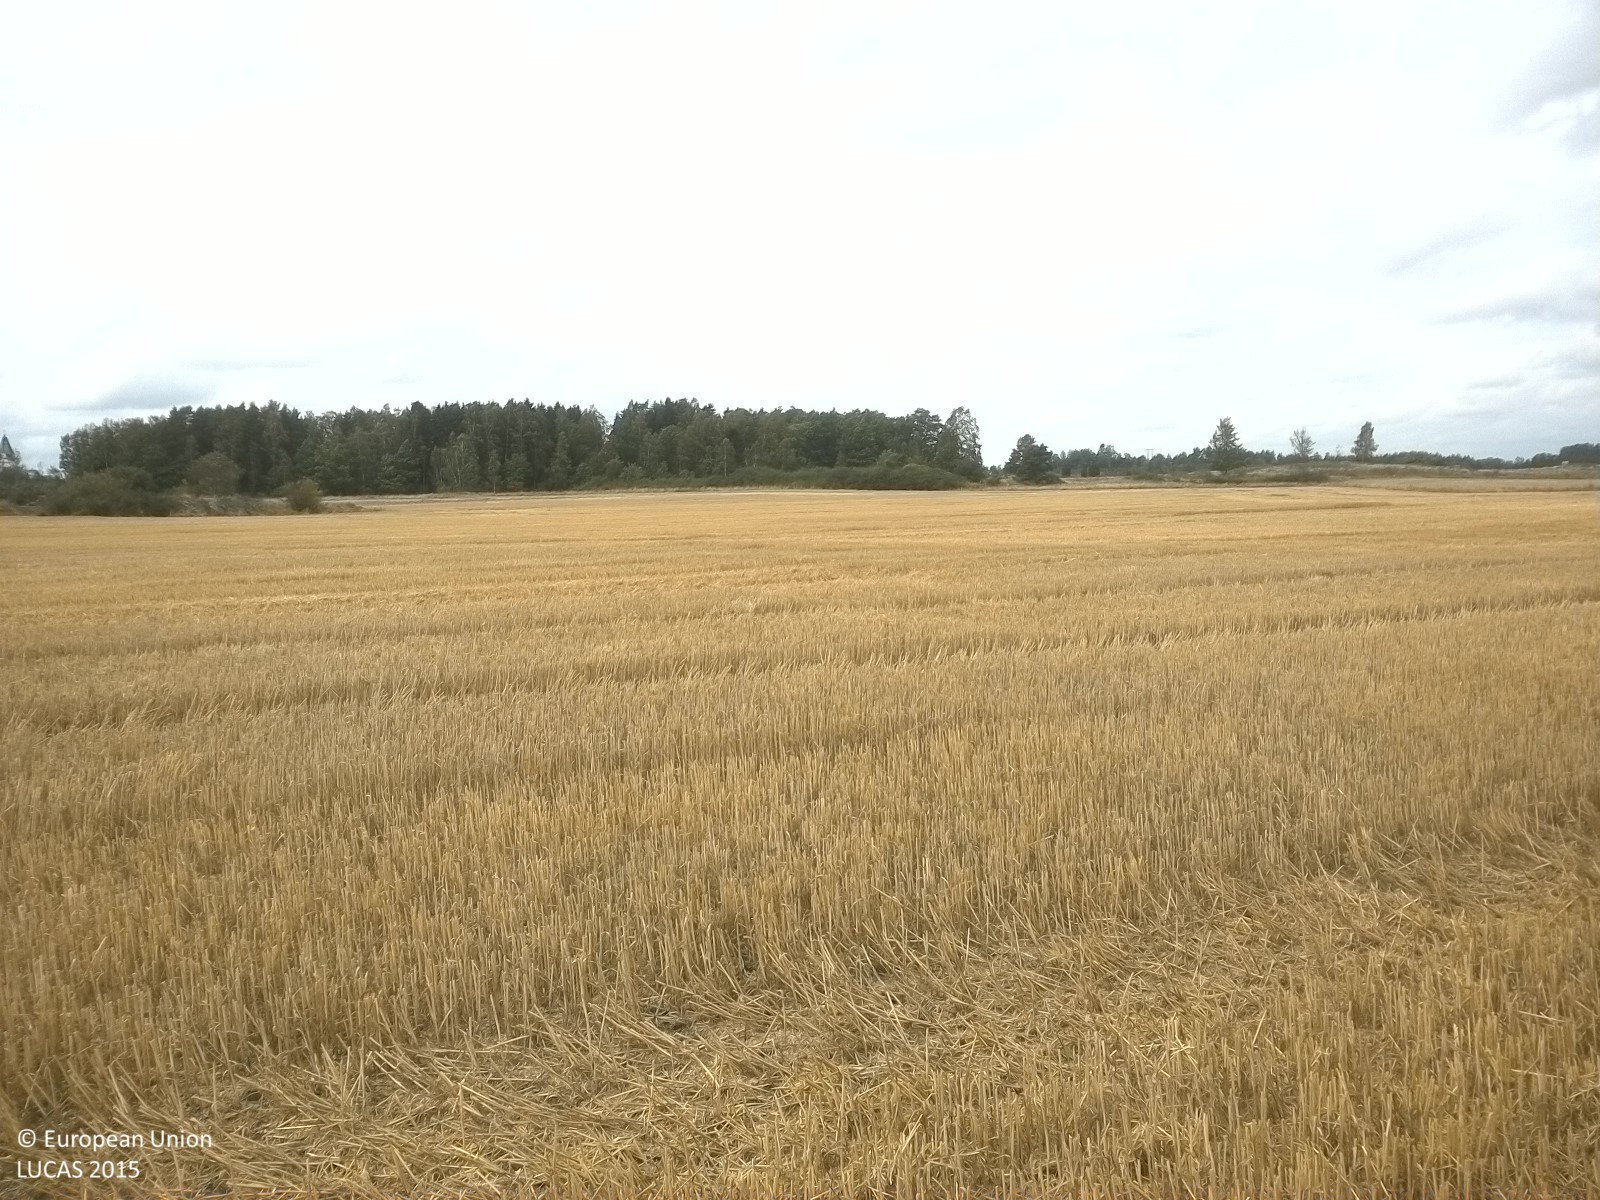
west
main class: Cropland
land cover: Common wheat
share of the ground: > 75 %
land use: Agriculture (excluding fallow land and kitchen gardens)
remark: Harvested field
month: September
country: SE
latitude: 58.5721
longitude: 16.4092
